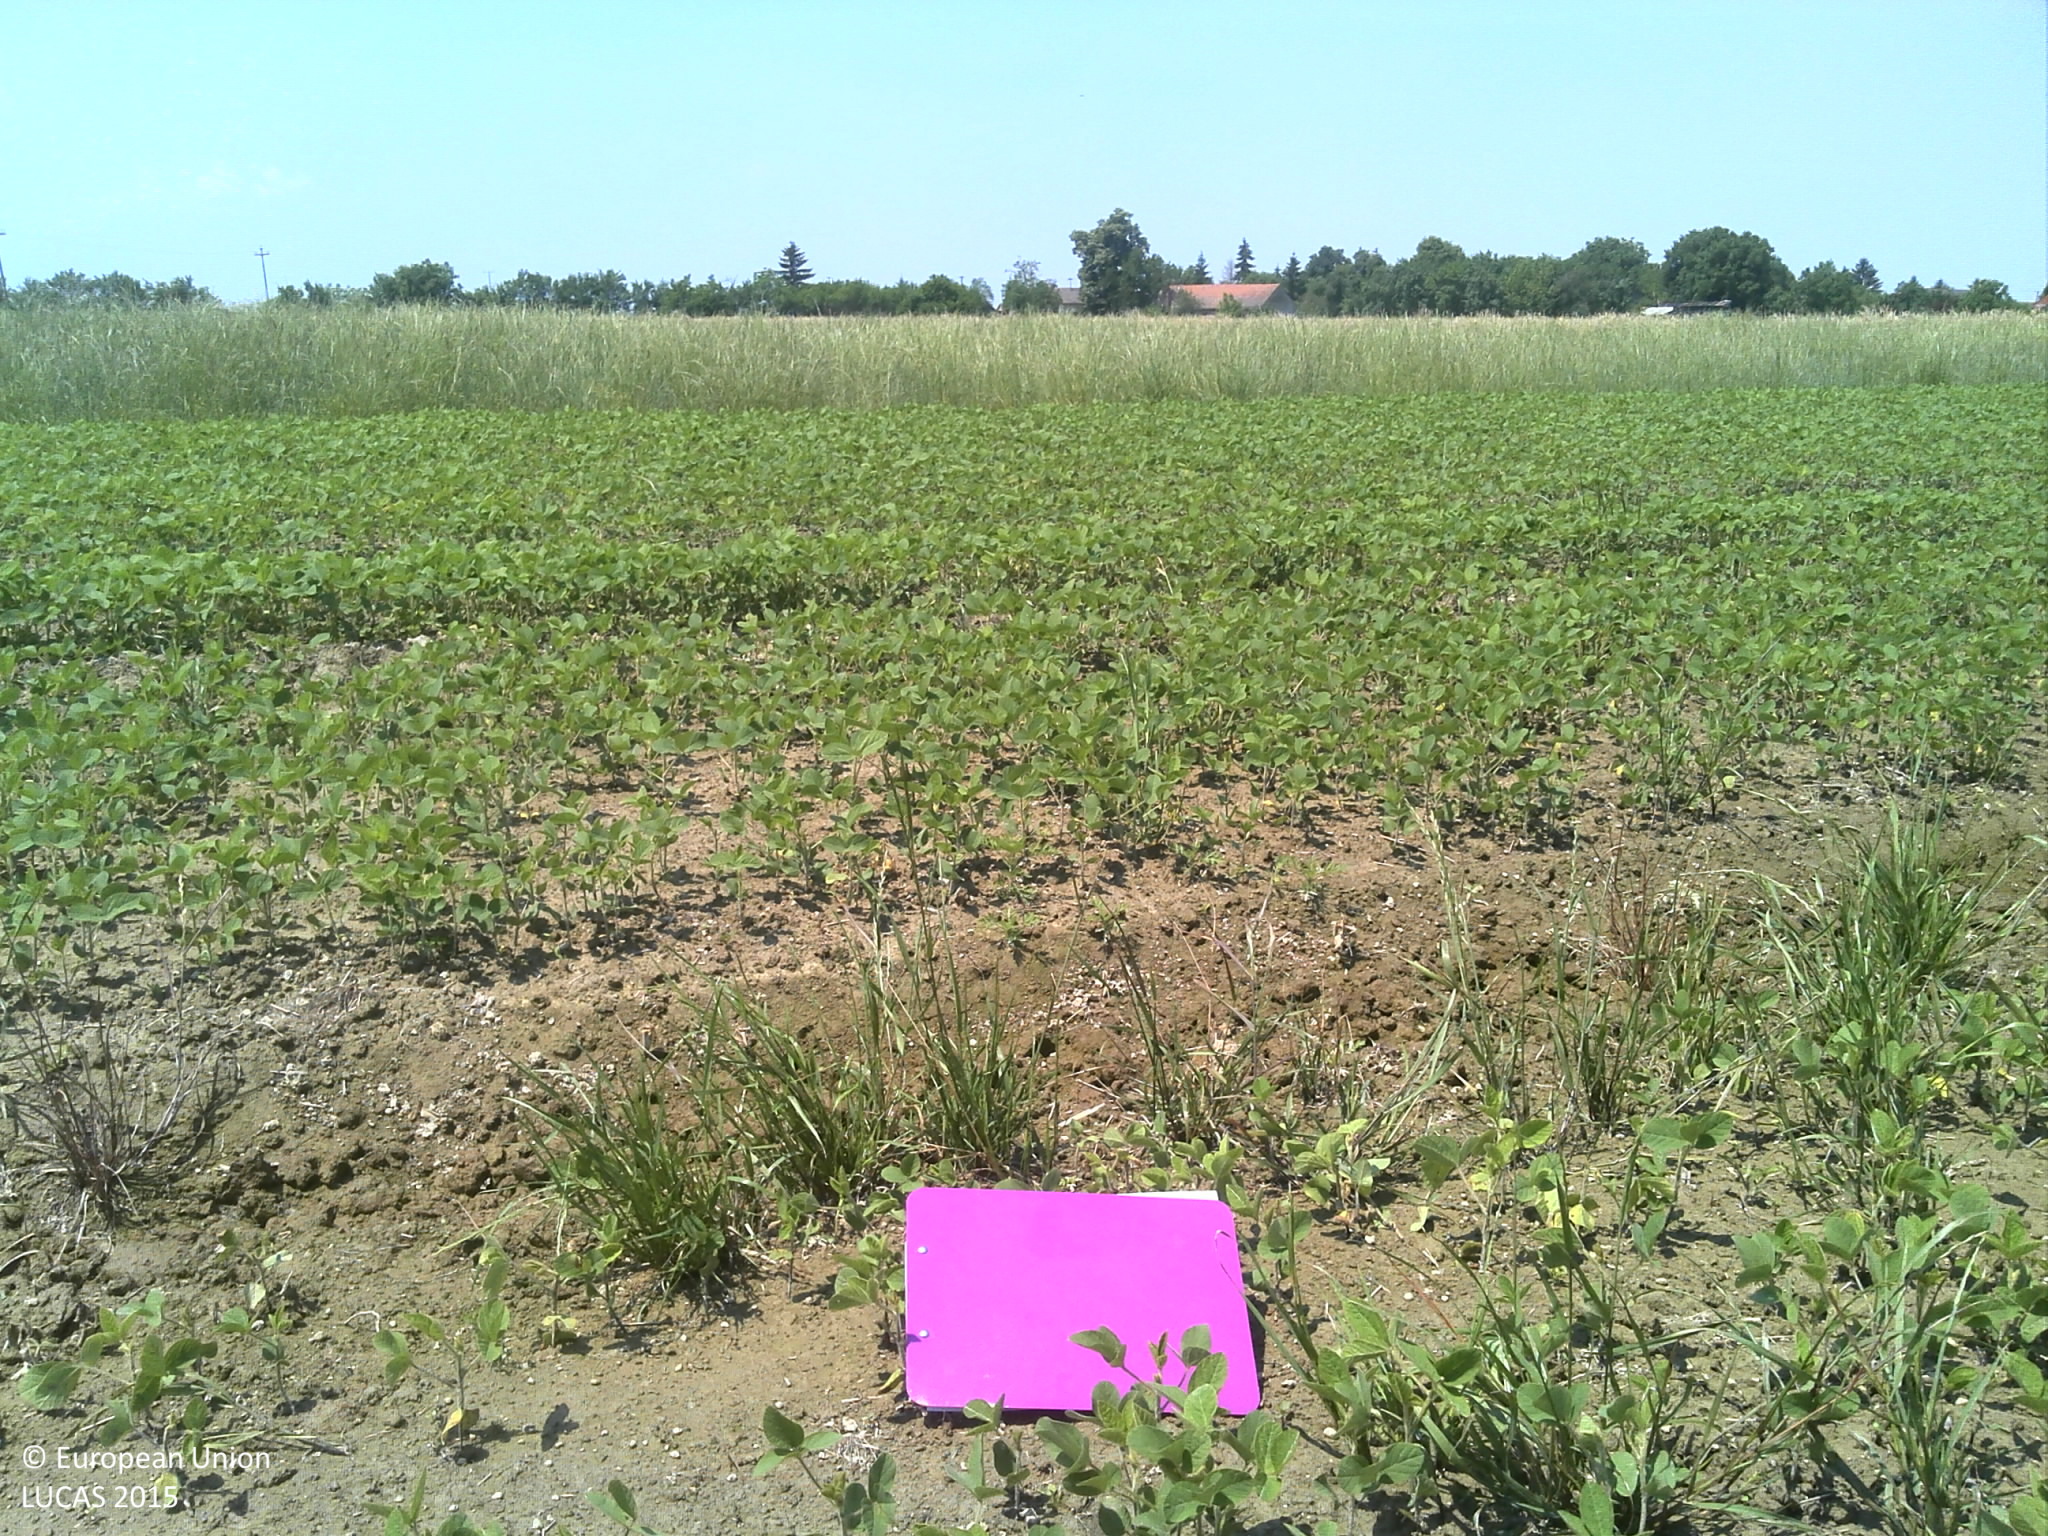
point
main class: Cropland
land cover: Soya
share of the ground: 25 - 50 %
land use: Agriculture (excluding fallow land and kitchen gardens)
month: June
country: HR
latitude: 45.6531
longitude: 17.9990
